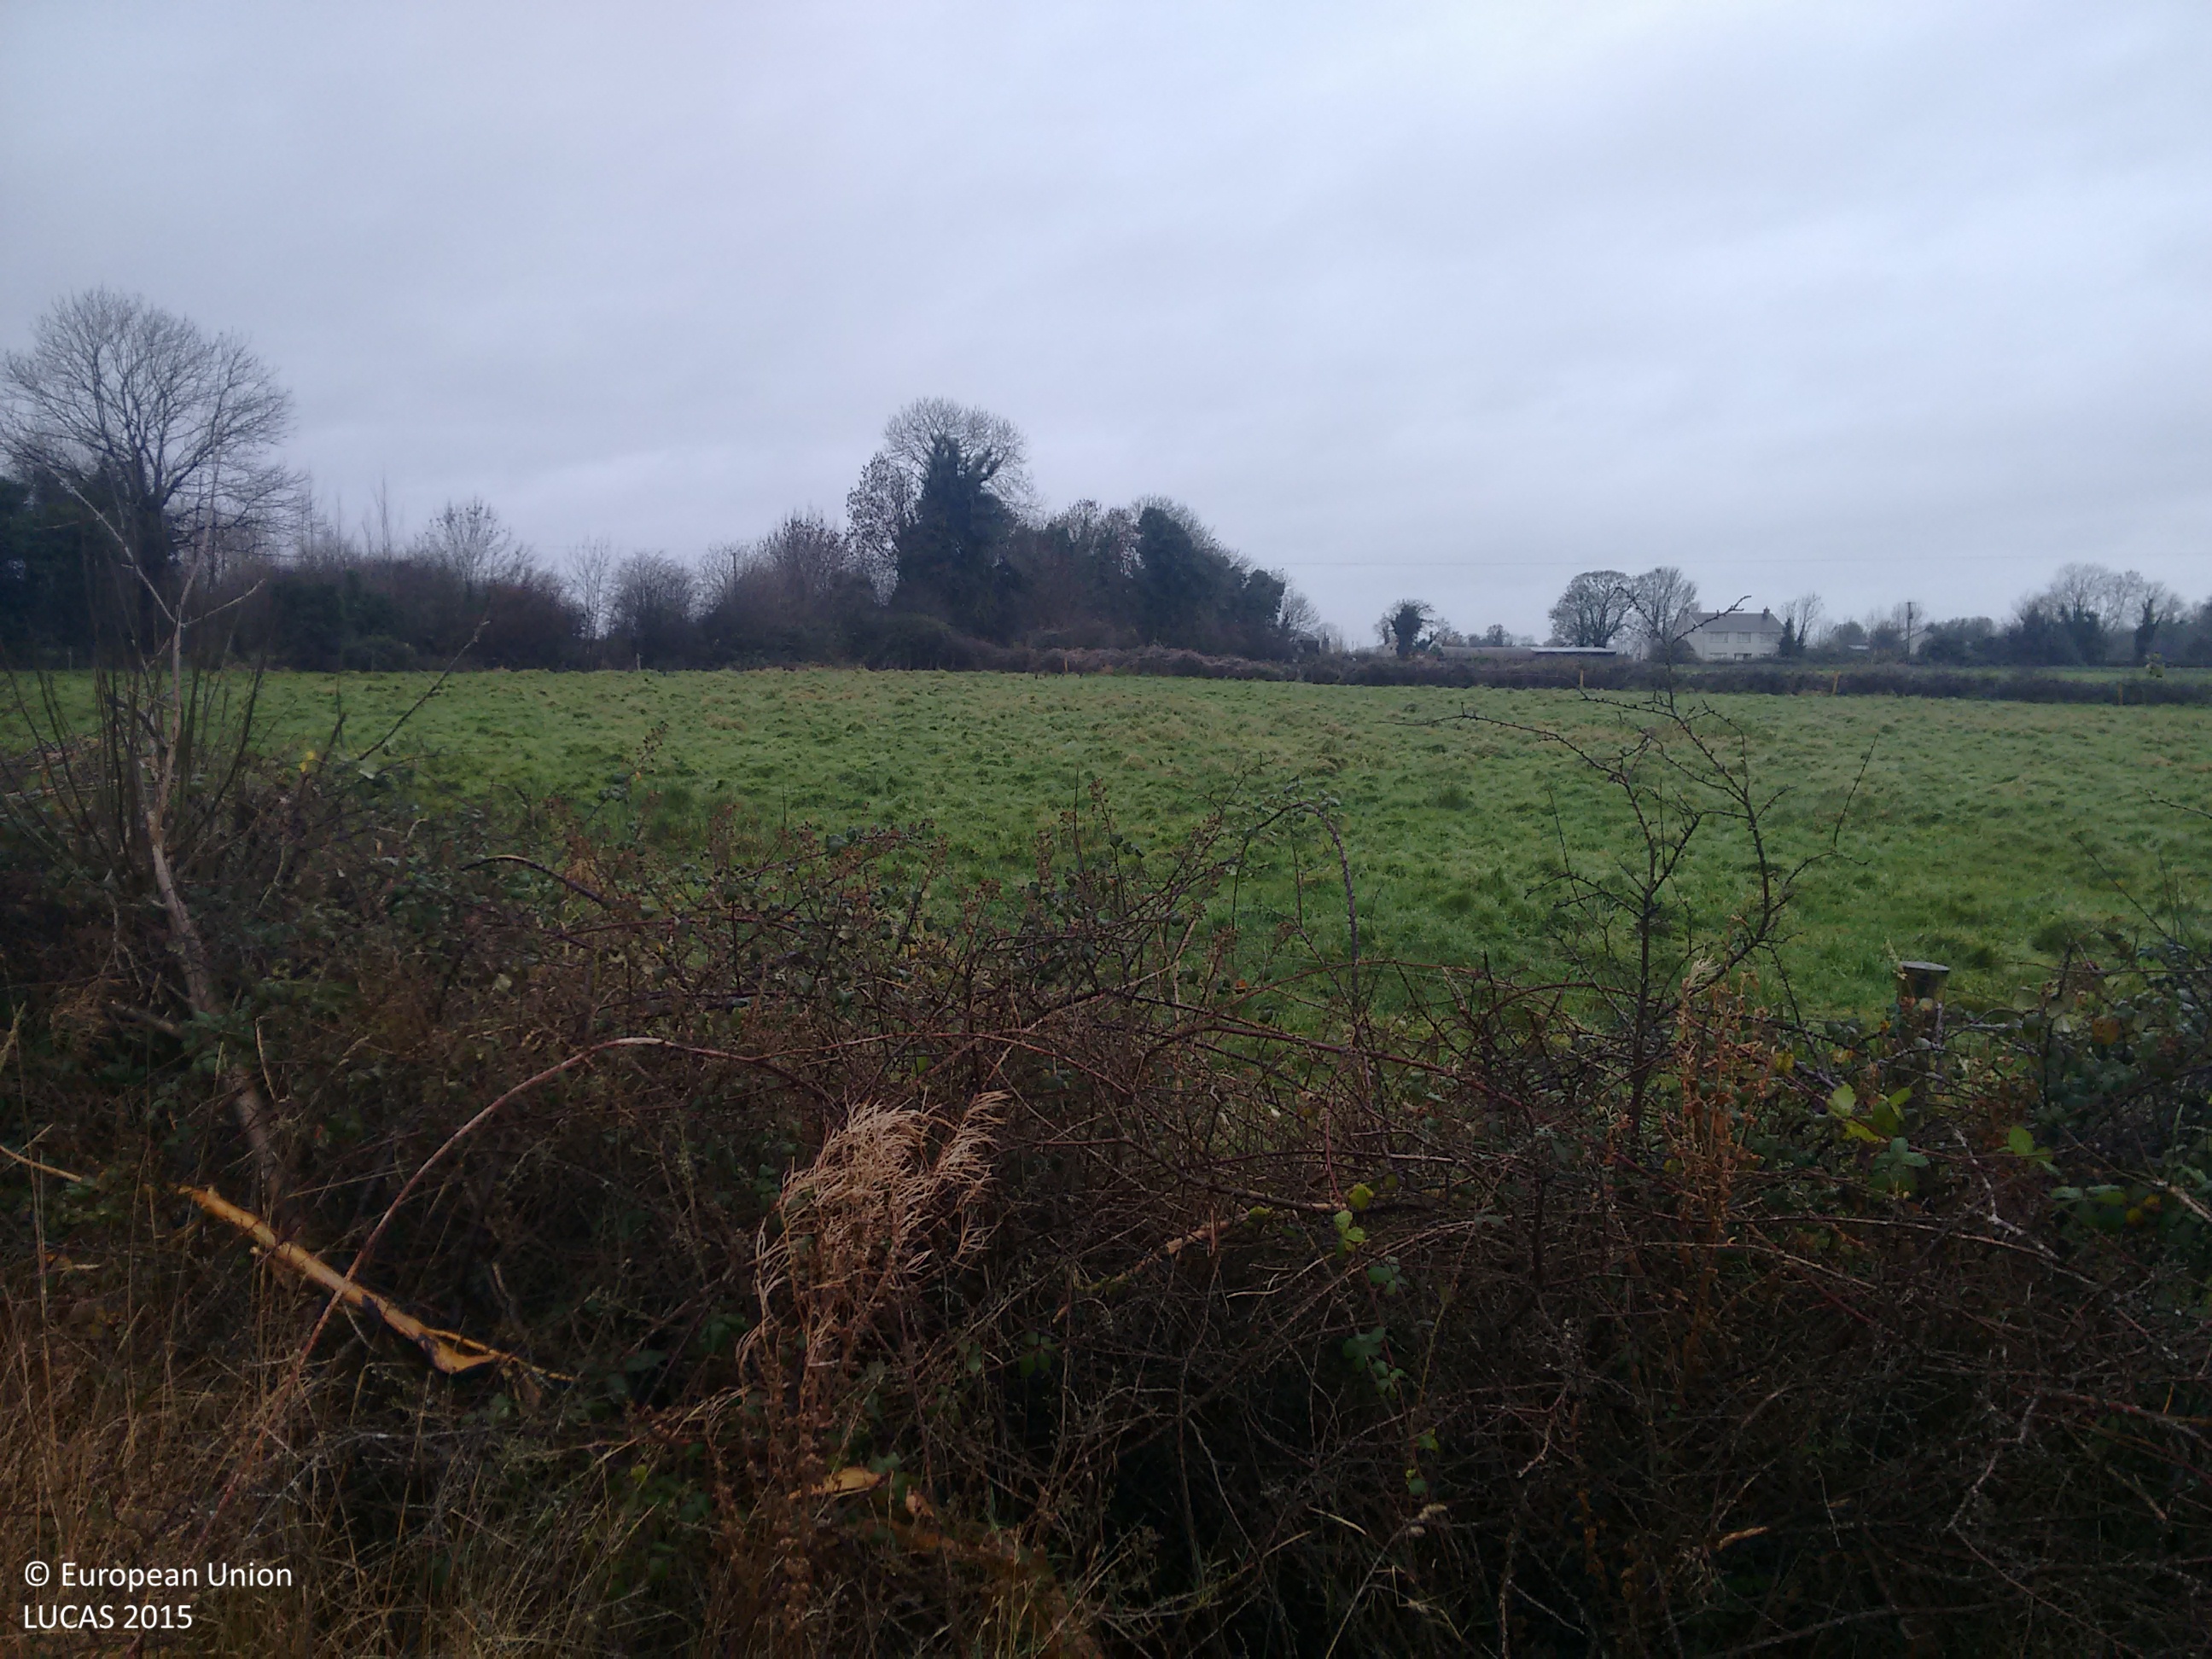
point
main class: Grassland
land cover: Grassland without tree/shrub cover
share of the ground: > 75 %
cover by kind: herbaceous plants 100 %
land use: Agriculture (excluding fallow land and kitchen gardens)
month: December
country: IE
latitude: 53.5847
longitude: -7.8900
